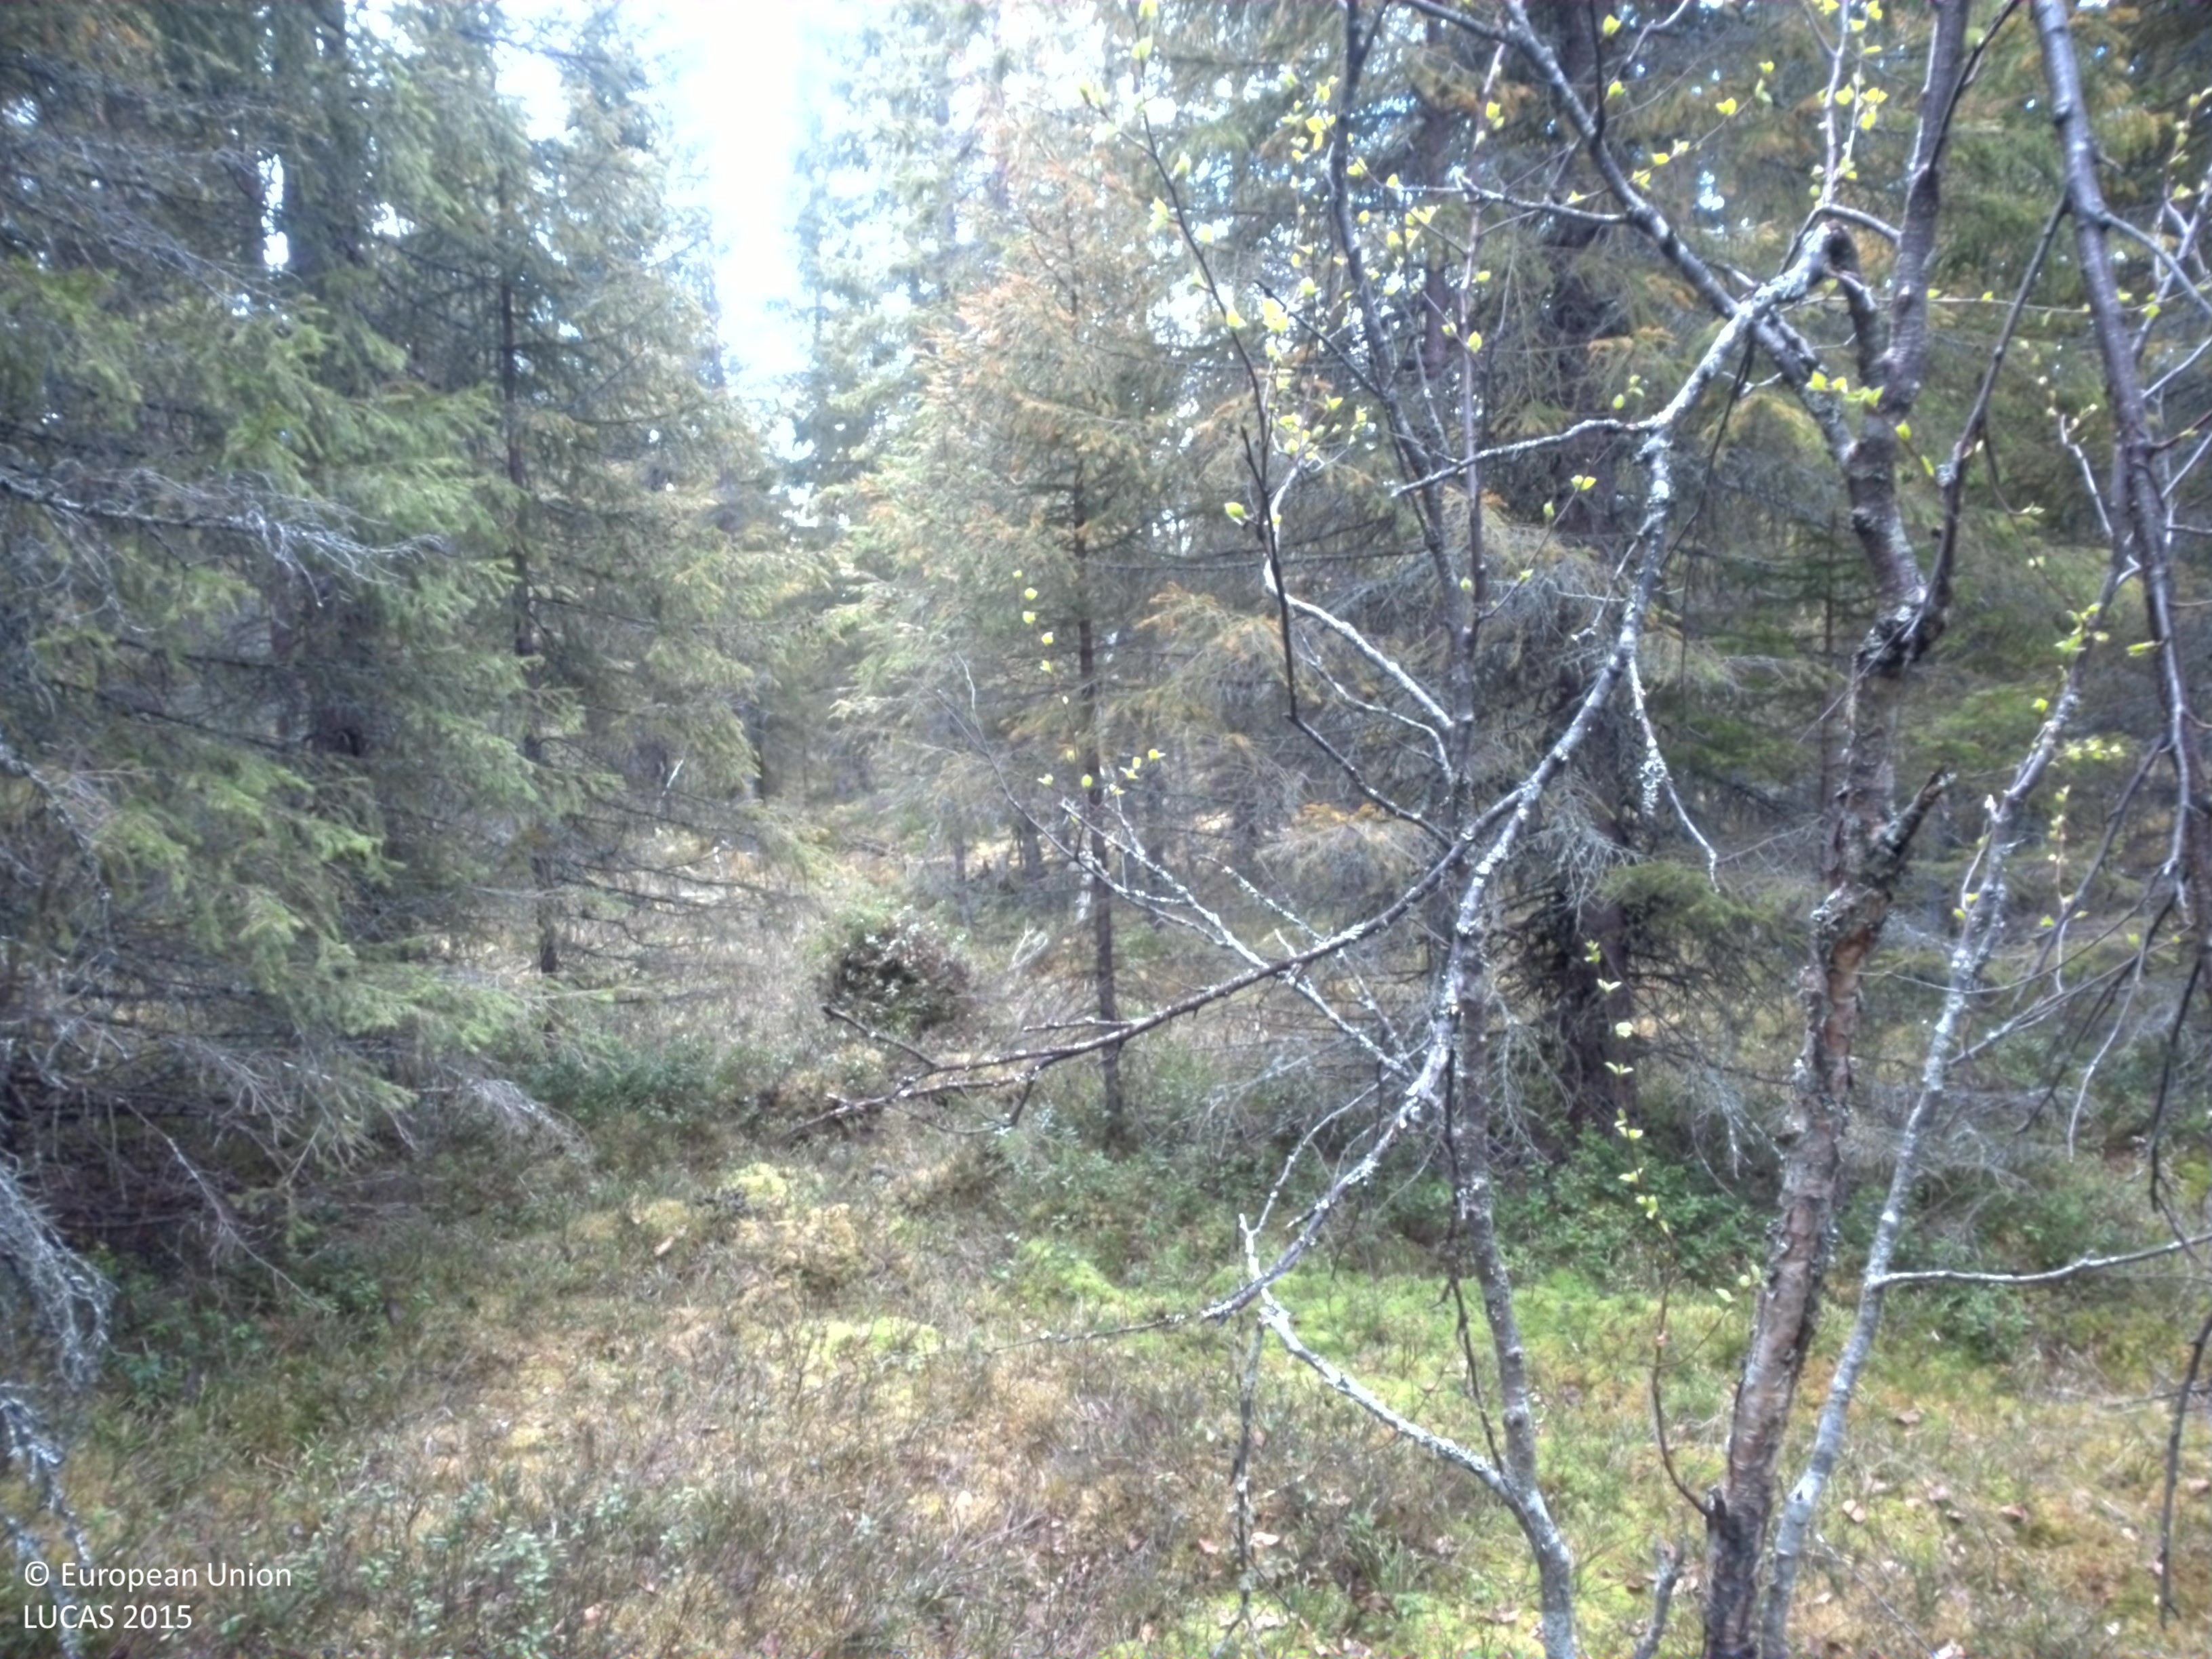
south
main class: Woodland
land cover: Spruce dominated coniferous woodland
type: boreal forest
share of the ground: 50 - 75 %
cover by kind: coniferous forest trees 55 %, herbaceous plants 20 %, lichens and mosses 15 %, broadleaved forest trees 5 %, shrubs 5 %
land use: Forestry
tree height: > 5 m
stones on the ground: < 10 %
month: June
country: SE
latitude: 64.3143
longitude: 18.1785
